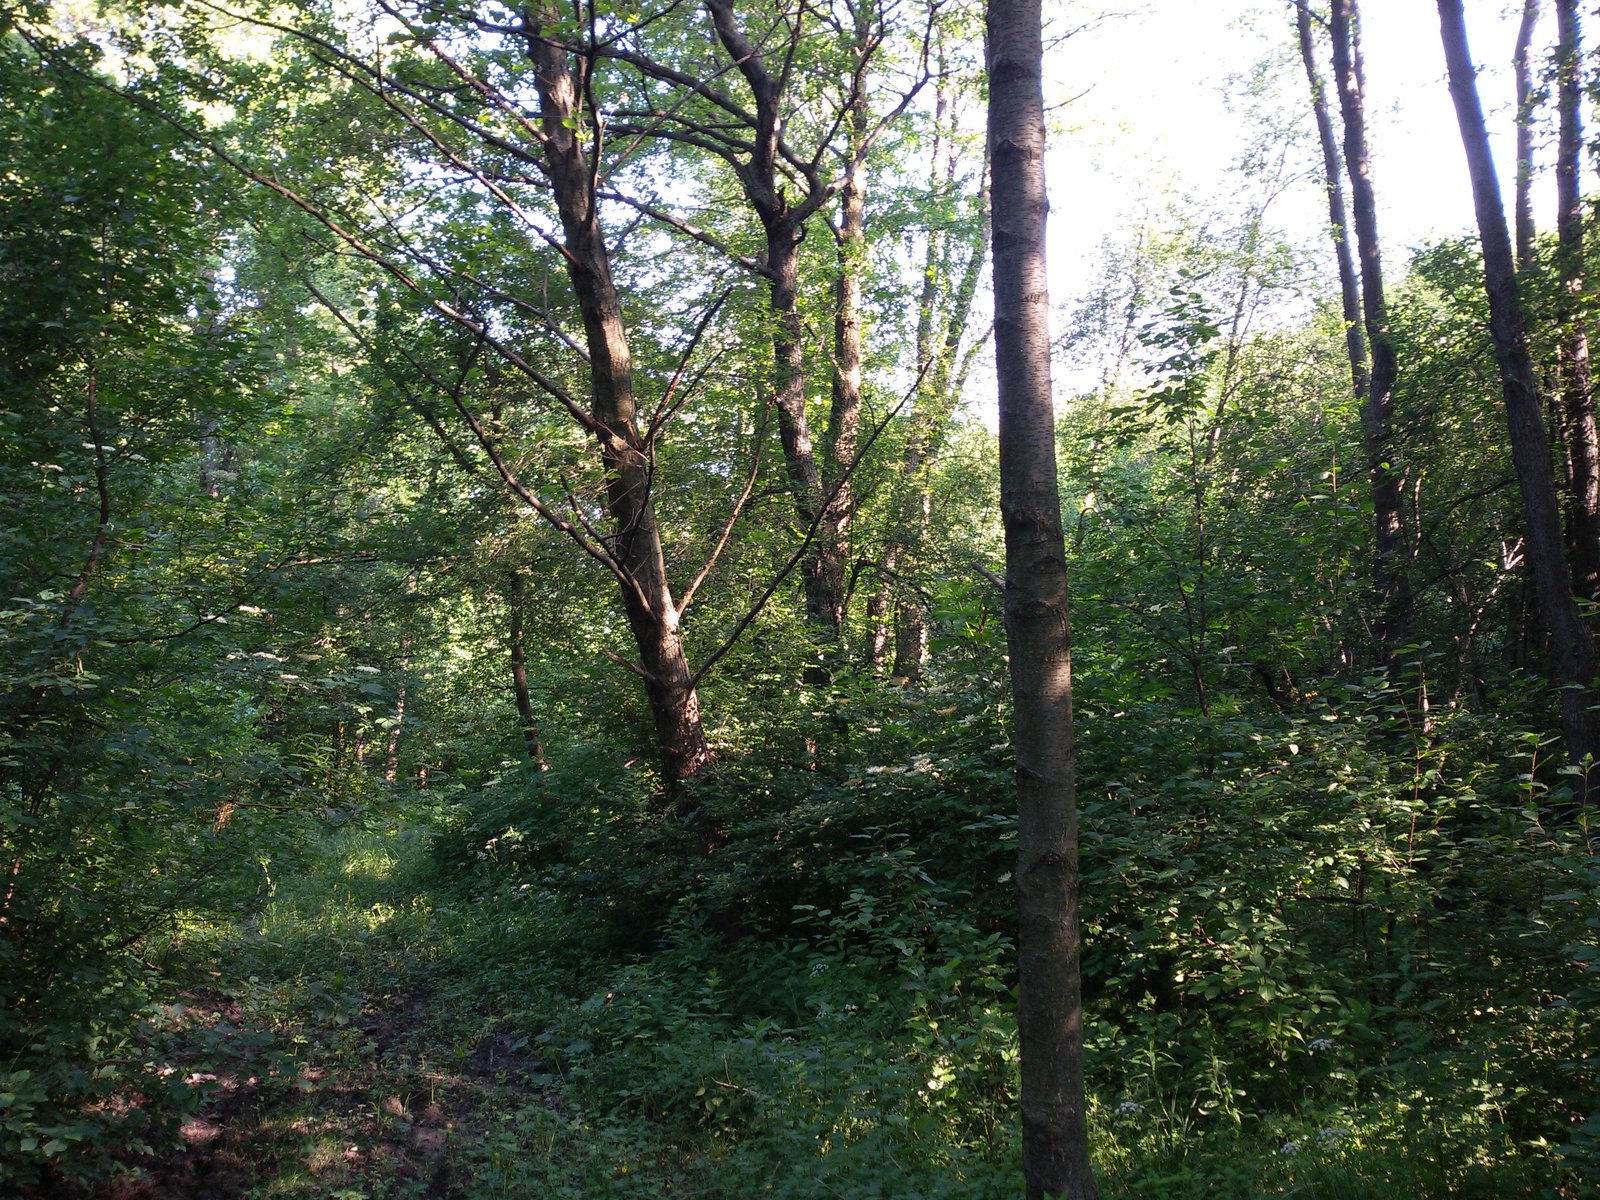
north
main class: Woodland
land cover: Broadleaved woodland
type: mesophytic deciduous forest
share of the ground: 50 - 75 %
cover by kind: broadleaved forest trees 70 %, shrubs 20 %, herbaceous plants 10 %
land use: Semi-natural and natural areas not in use
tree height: > 5 m
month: June
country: PL
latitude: 50.0264
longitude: 21.5954
